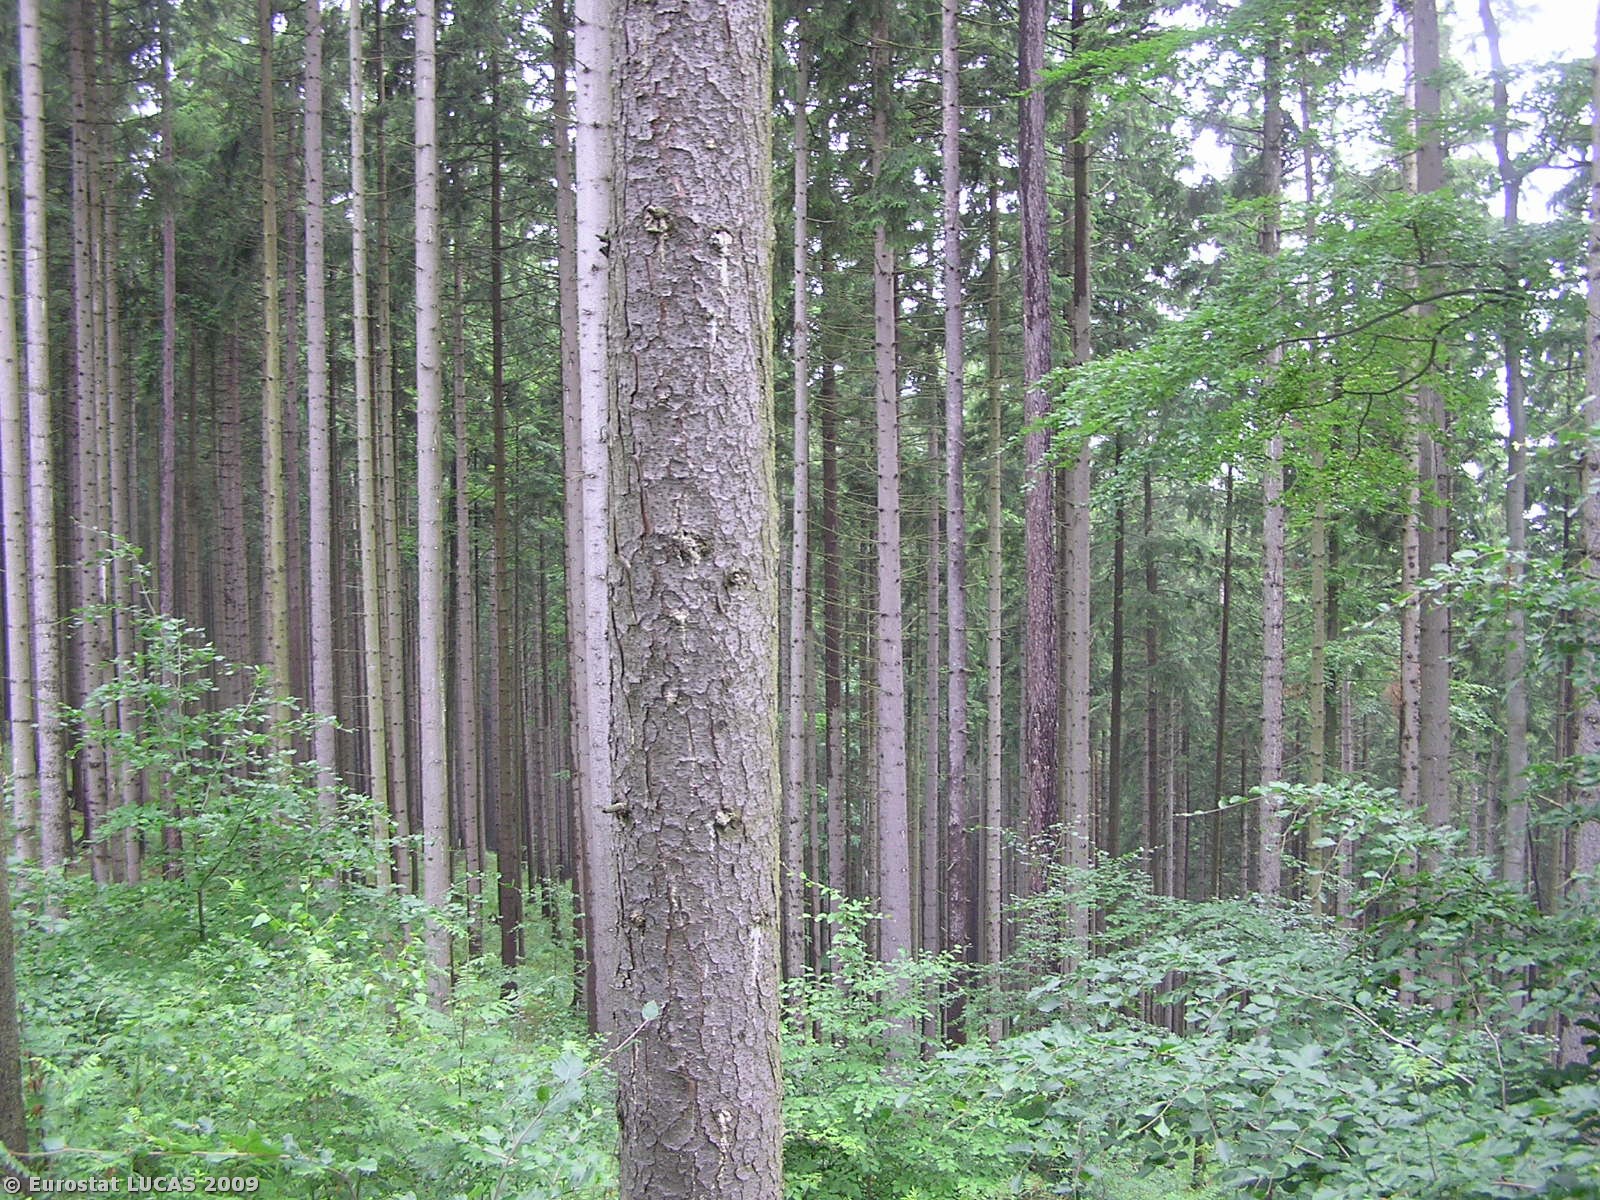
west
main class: Woodland
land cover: Mixed woodland
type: hemiboreal forest and nemoral coniferous forest and mixed broadleaved-coniferous forest
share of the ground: > 75 %
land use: Forestry
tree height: > 5 m
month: June
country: CZ
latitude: 50.1038
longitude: 17.4362
